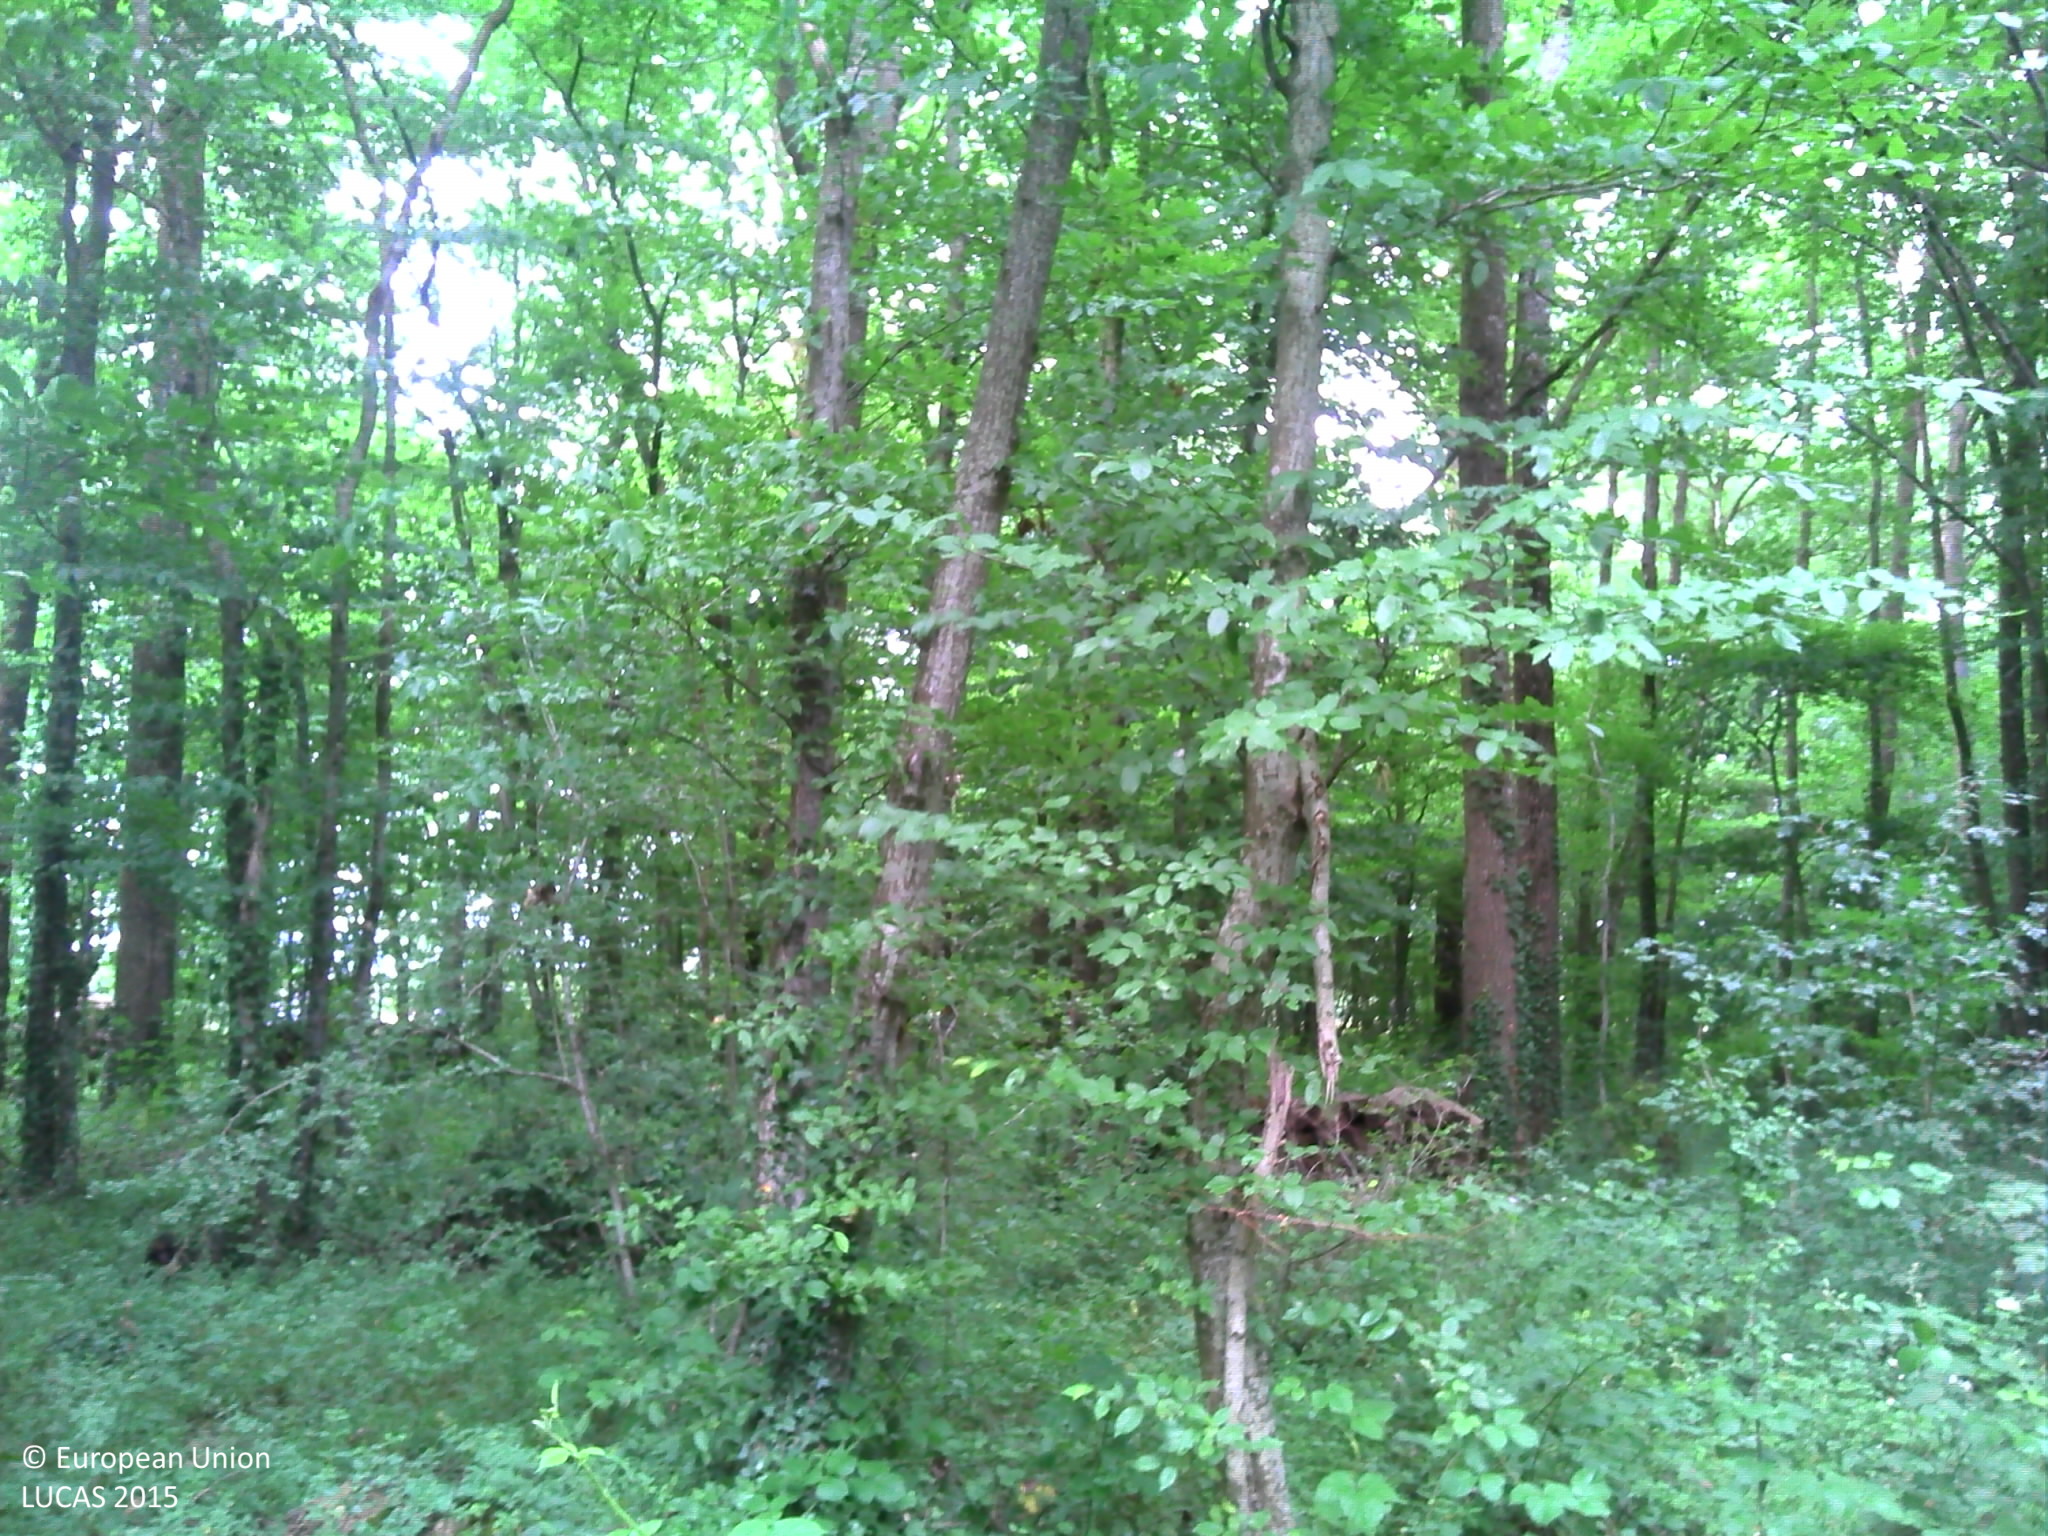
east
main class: Woodland
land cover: Broadleaved woodland
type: beech forest
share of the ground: > 75 %
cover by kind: broadleaved forest trees 65 %, herbaceous plants 20 %, shrubs 15 %
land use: Forestry
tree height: > 5 m
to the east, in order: Broadleaved woodland; Fences; Grassland without tree/shrub cover
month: June
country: FR
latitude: 48.1177
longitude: 0.2620
